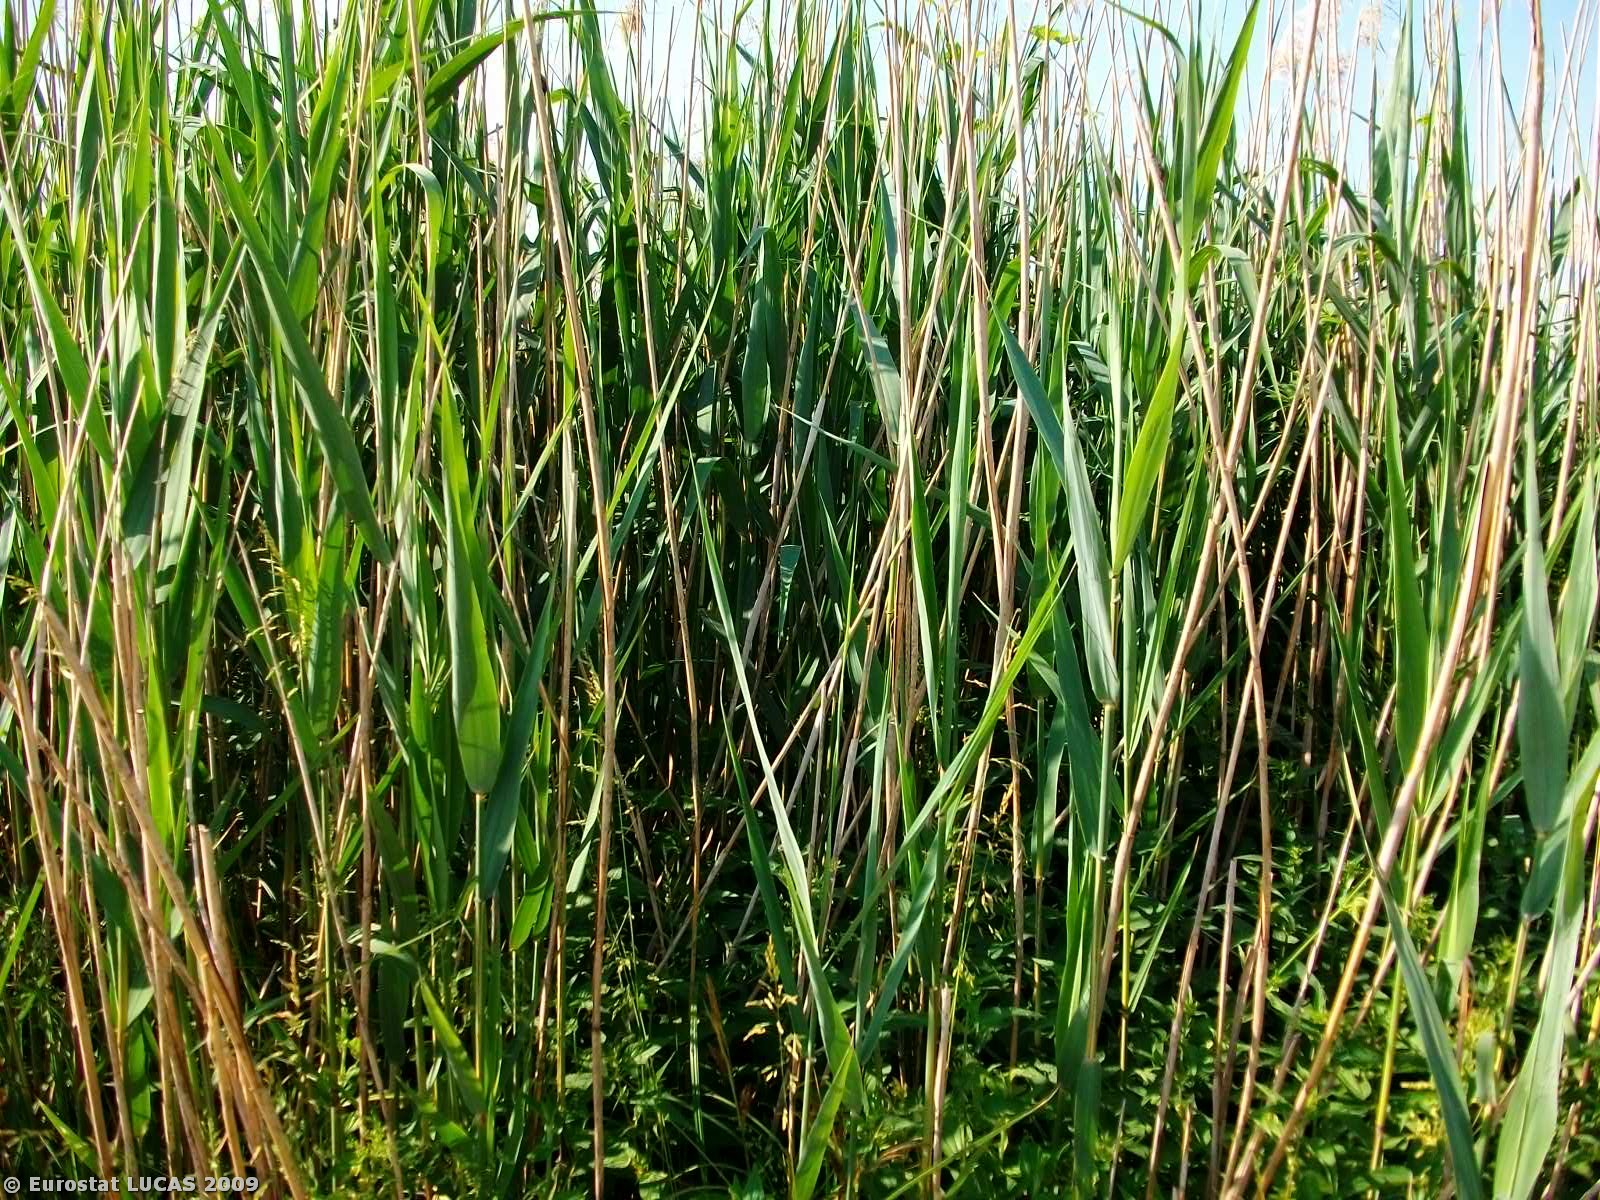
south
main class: Wetlands
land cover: Inland marshes
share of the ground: > 75 %
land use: Unused
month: May
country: GR
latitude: 39.8730
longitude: 20.6070
